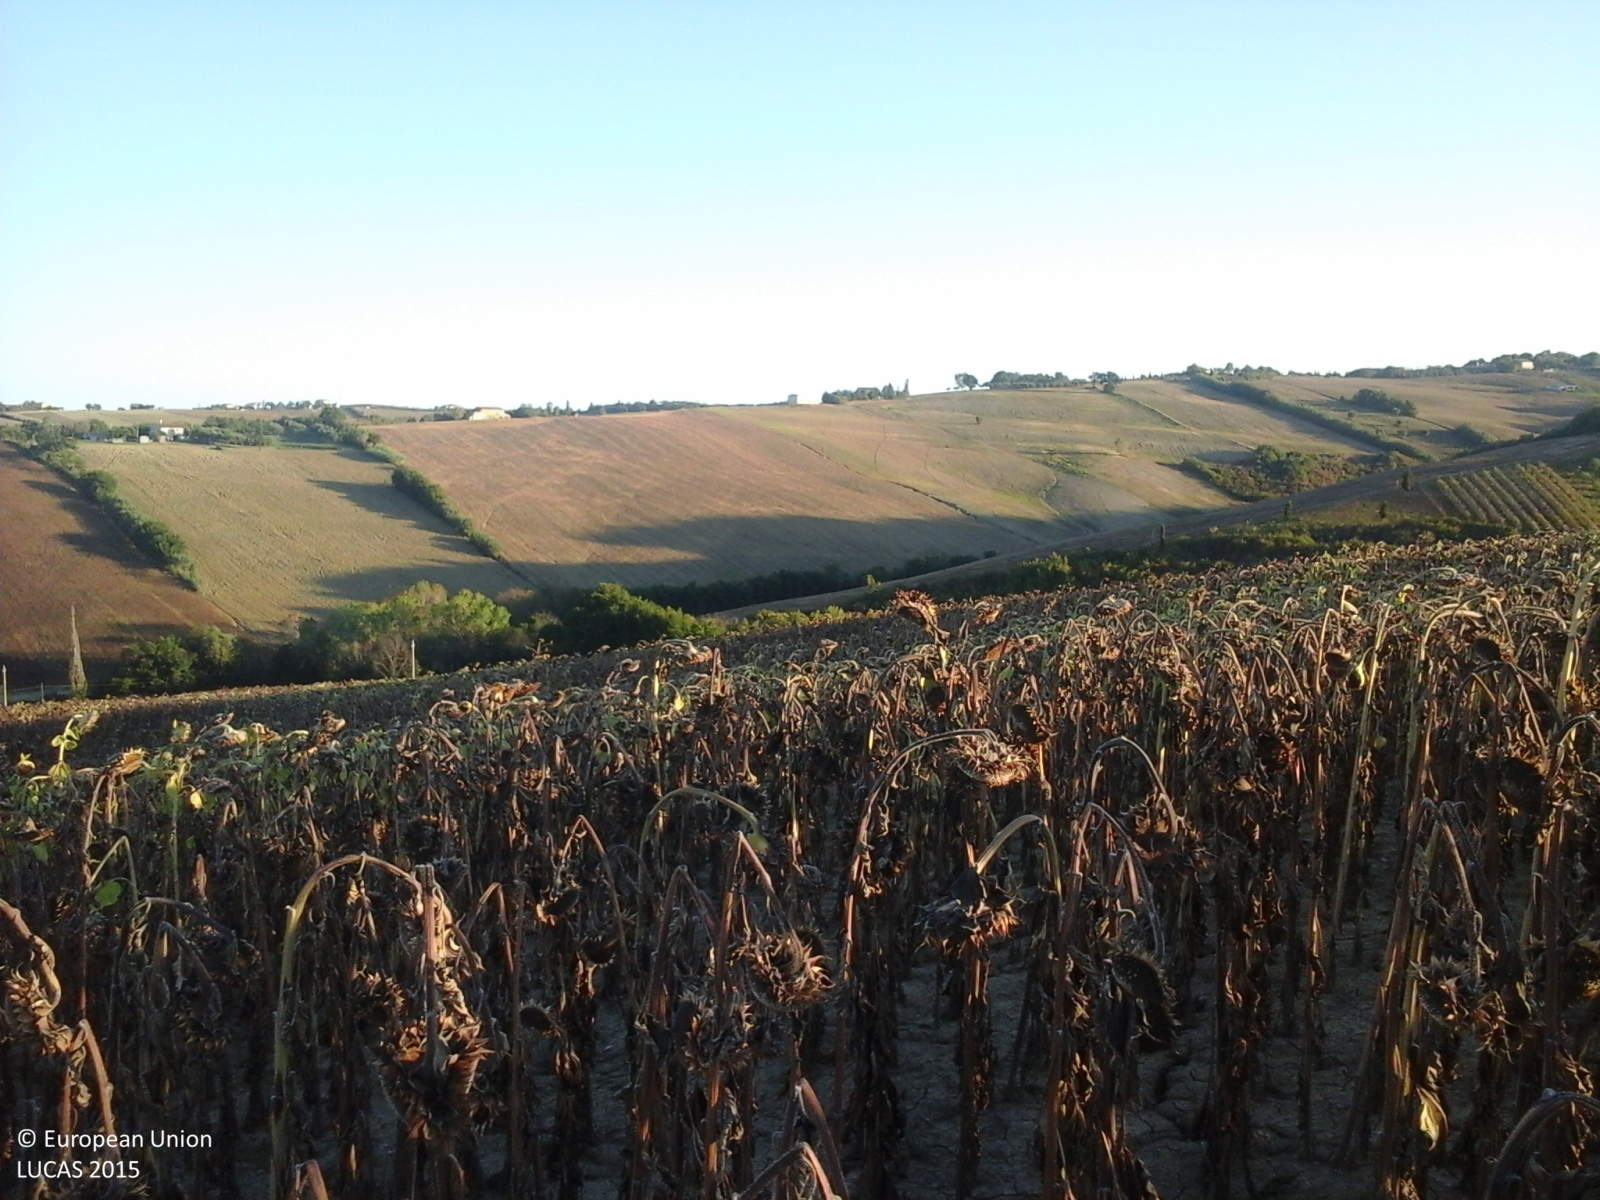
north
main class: Cropland
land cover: Sunflower
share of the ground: > 75 %
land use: Agriculture (excluding fallow land and kitchen gardens)
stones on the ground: < 10 %
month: September
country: IT
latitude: 43.6932
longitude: 13.0077
